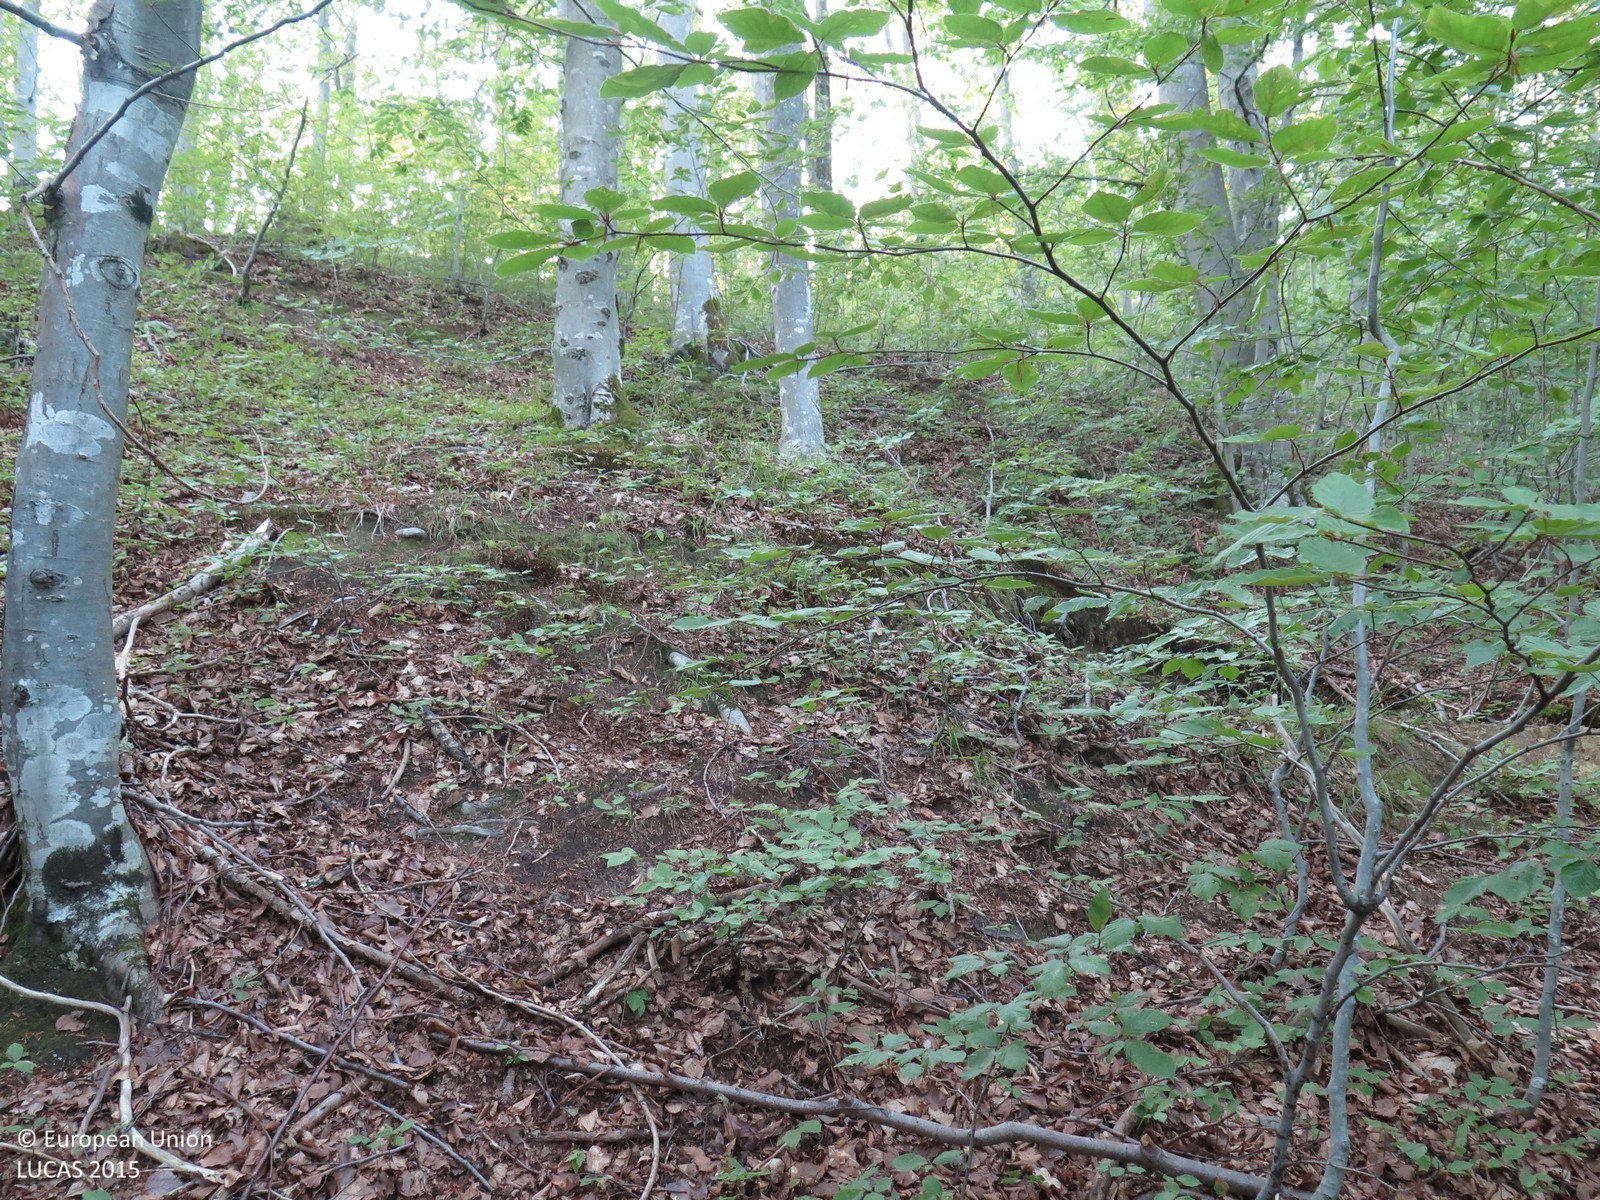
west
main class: Woodland
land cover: Broadleaved woodland
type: beech forest
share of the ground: > 75 %
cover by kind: broadleaved forest trees 95 %, lichens and mosses 5 %
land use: Forestry
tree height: > 5 m
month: August
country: HR
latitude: 45.4416
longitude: 14.9686
